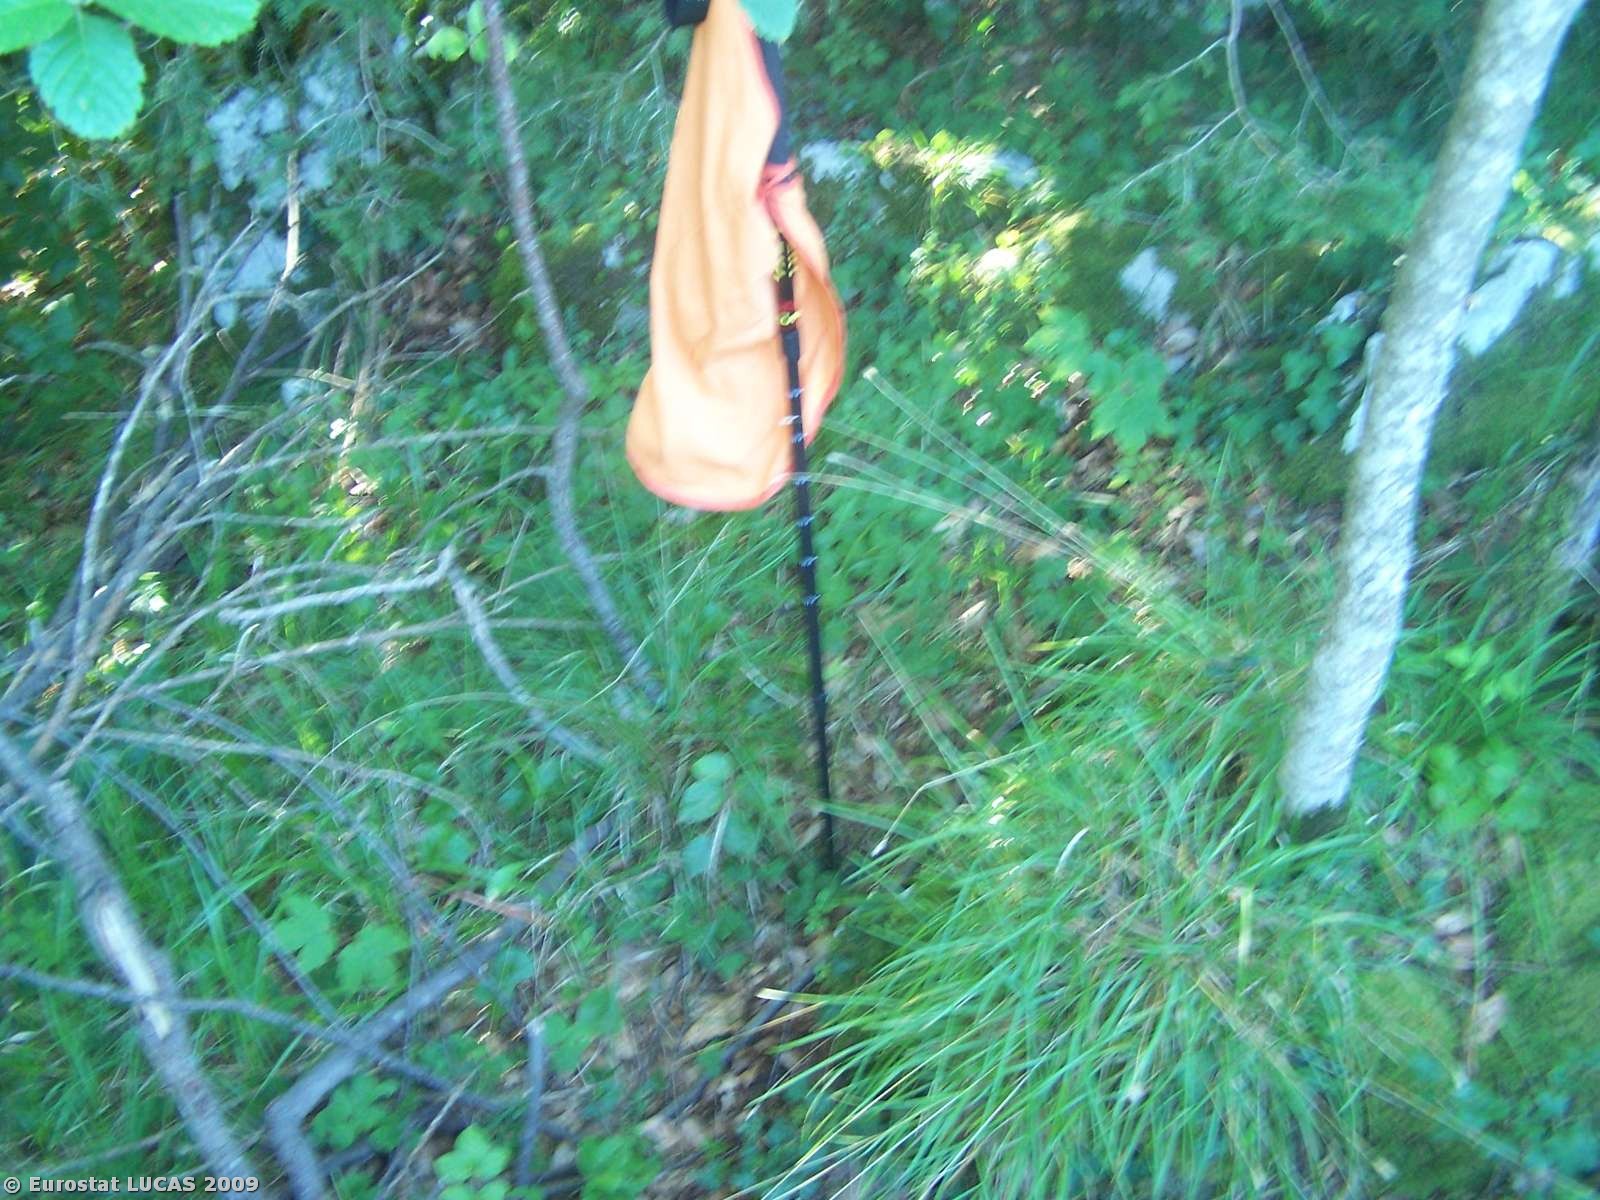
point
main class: Woodland
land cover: Mixed woodland
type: mesophytic deciduous forest
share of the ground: > 75 %
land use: Forestry
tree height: > 5 m
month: July
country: IT
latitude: 46.2373
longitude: 12.9924
